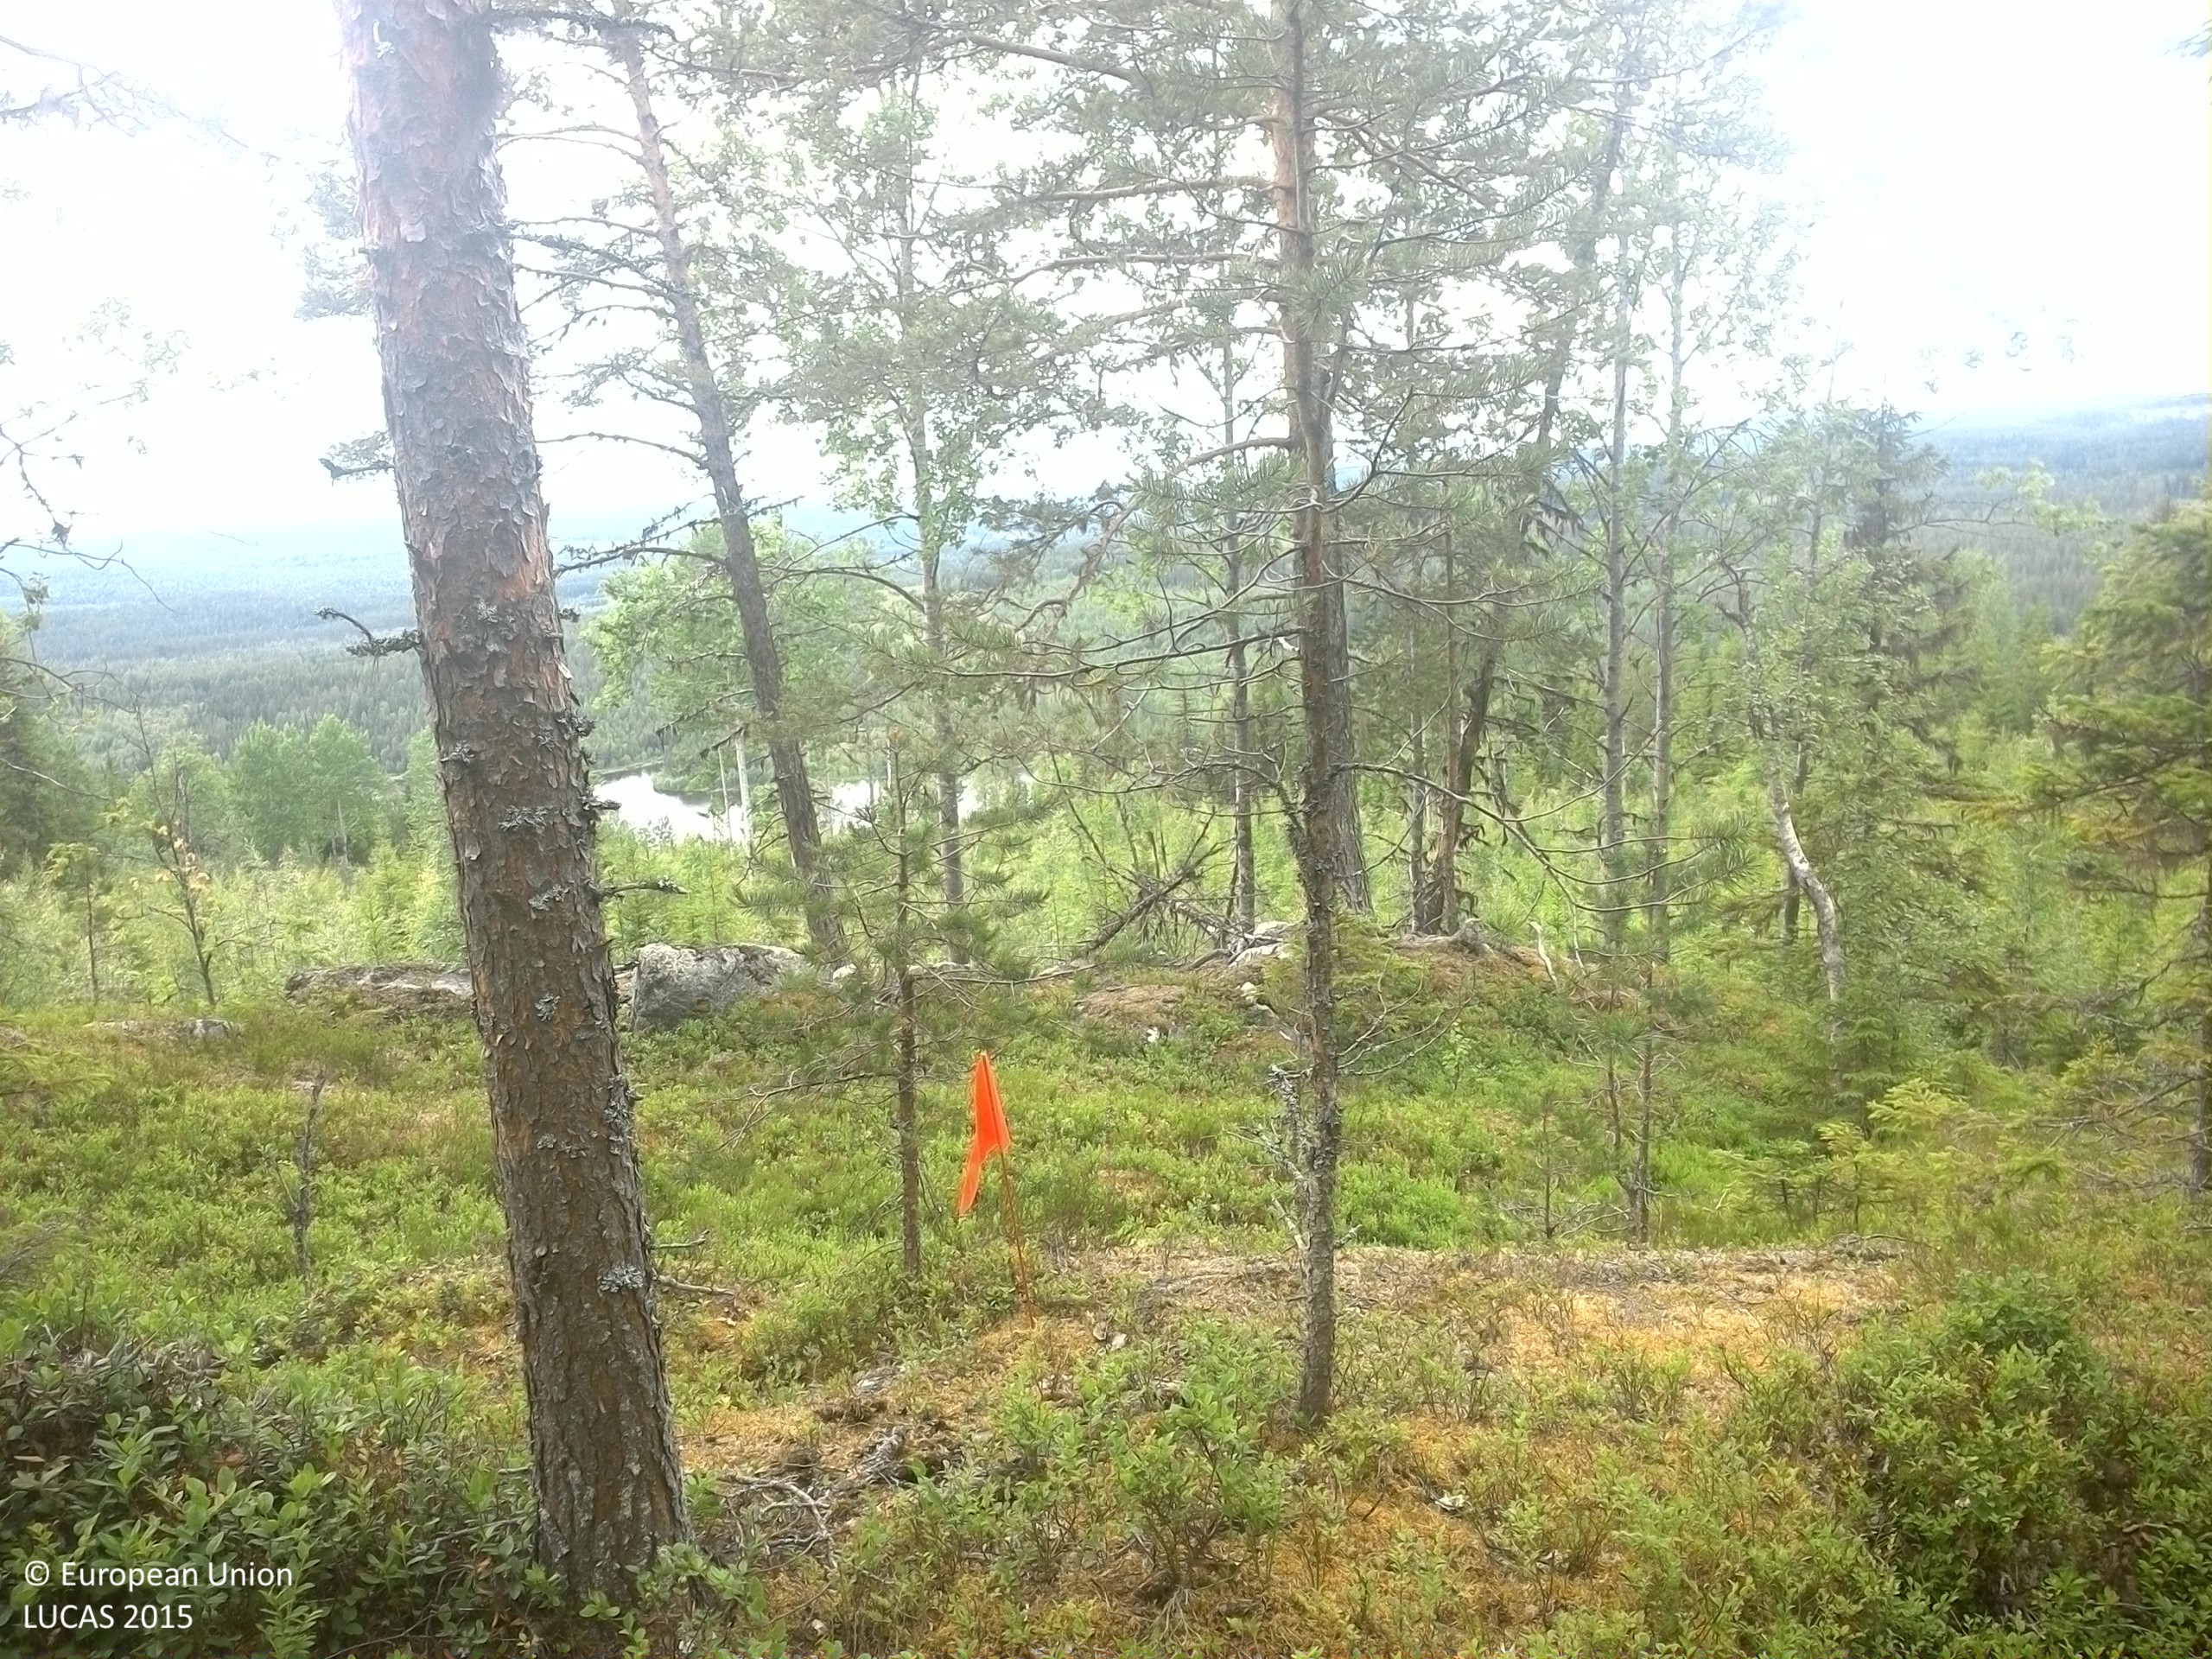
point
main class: Woodland
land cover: Pine dominated mixed woodland
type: boreal forest
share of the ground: 50 - 75 %
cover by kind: coniferous forest trees 45 %, shrubs 20 %, broadleaved forest trees 15 %, lichens and mosses 10 %, consolidated bare surface 10 %
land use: Forestry
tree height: > 5 m
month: July
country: SE
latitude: 63.5665
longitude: 17.8870
